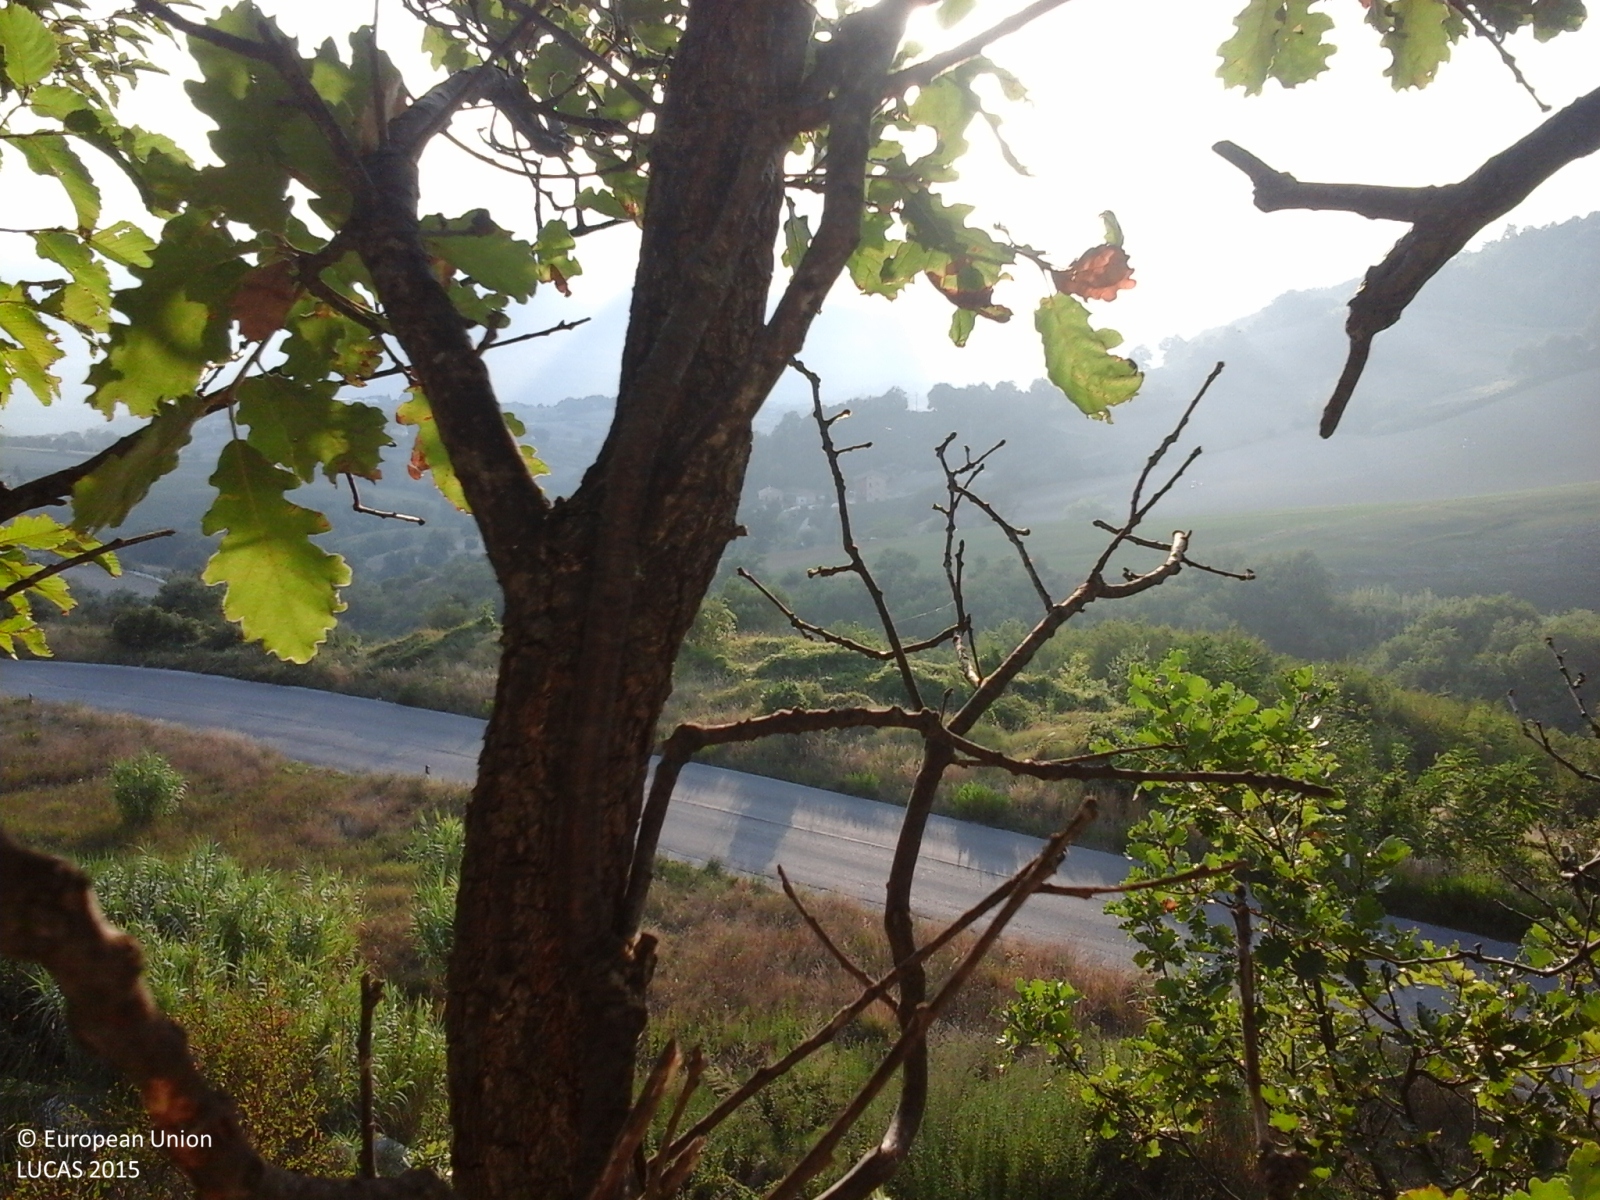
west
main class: Woodland
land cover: Broadleaved woodland
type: thermophilous deciduous forest
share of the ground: > 75 %
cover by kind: broadleaved forest trees 90 %, shrubs 5 %, herbaceous plants 5 %
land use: Forestry
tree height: > 5 m
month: August
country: IT
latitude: 43.4003
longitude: 13.1405
